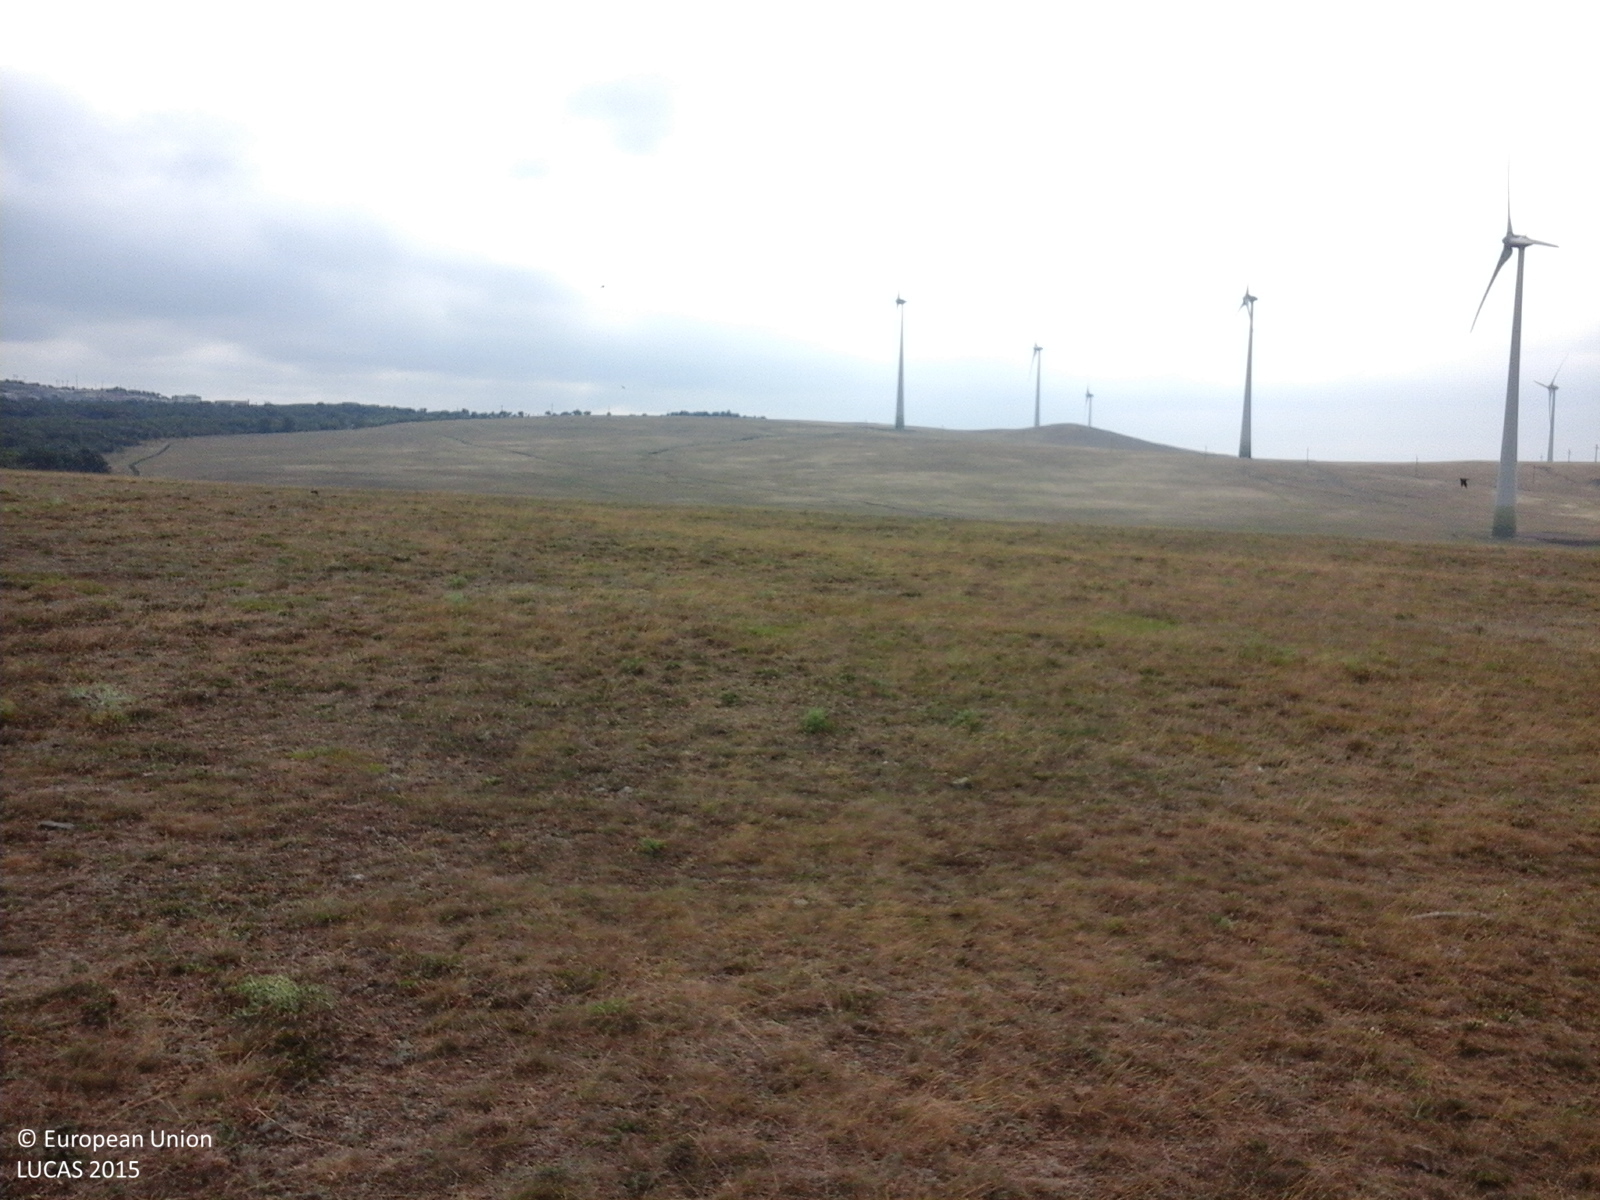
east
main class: Grassland
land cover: Grassland without tree/shrub cover
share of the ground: > 75 %
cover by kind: herbaceous plants 100 %
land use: Agriculture (excluding fallow land and kitchen gardens)
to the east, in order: Grassland without tree/shrub cover; Tracks; Grassland without tree/shrub cover; Tracks; Grassland without tree/shrub cover
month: August
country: RO
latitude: 44.7851
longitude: 28.5426
